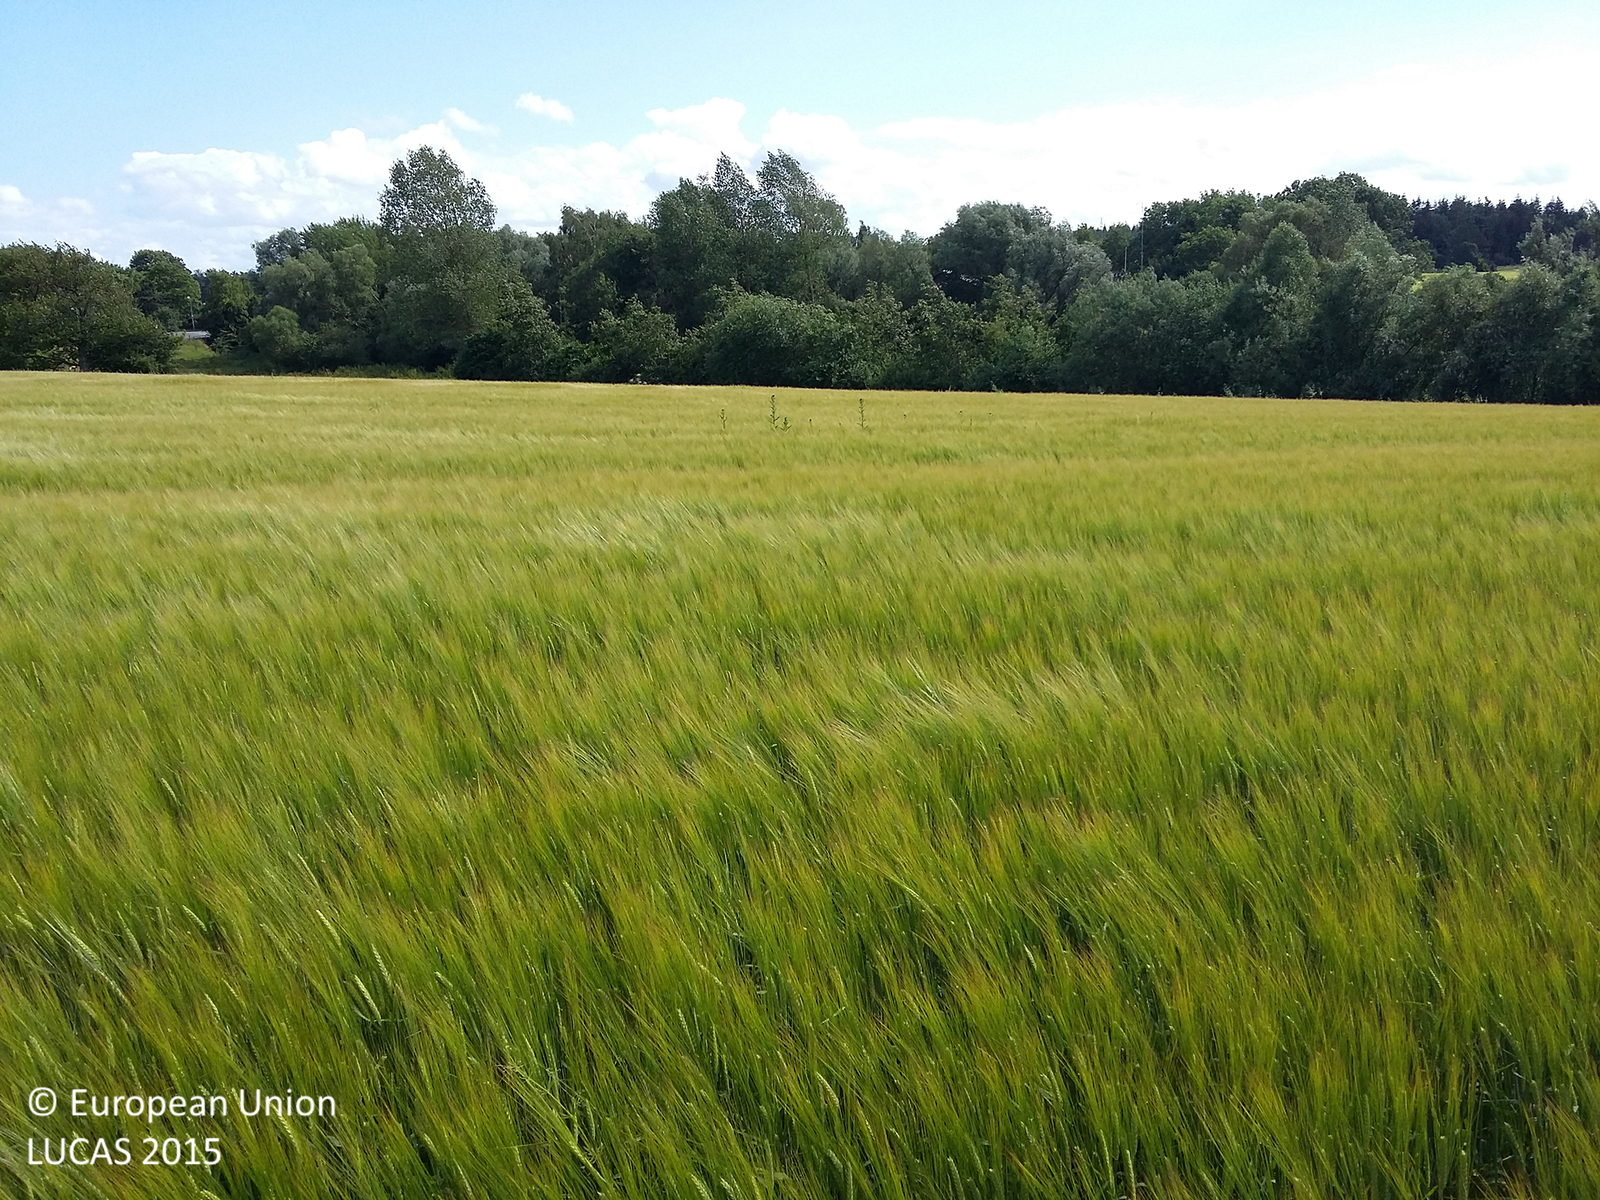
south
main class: Cropland
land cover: Barley
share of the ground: > 75 %
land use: Agriculture (excluding fallow land and kitchen gardens)
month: July
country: DK
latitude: 55.1867
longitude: 11.7735
